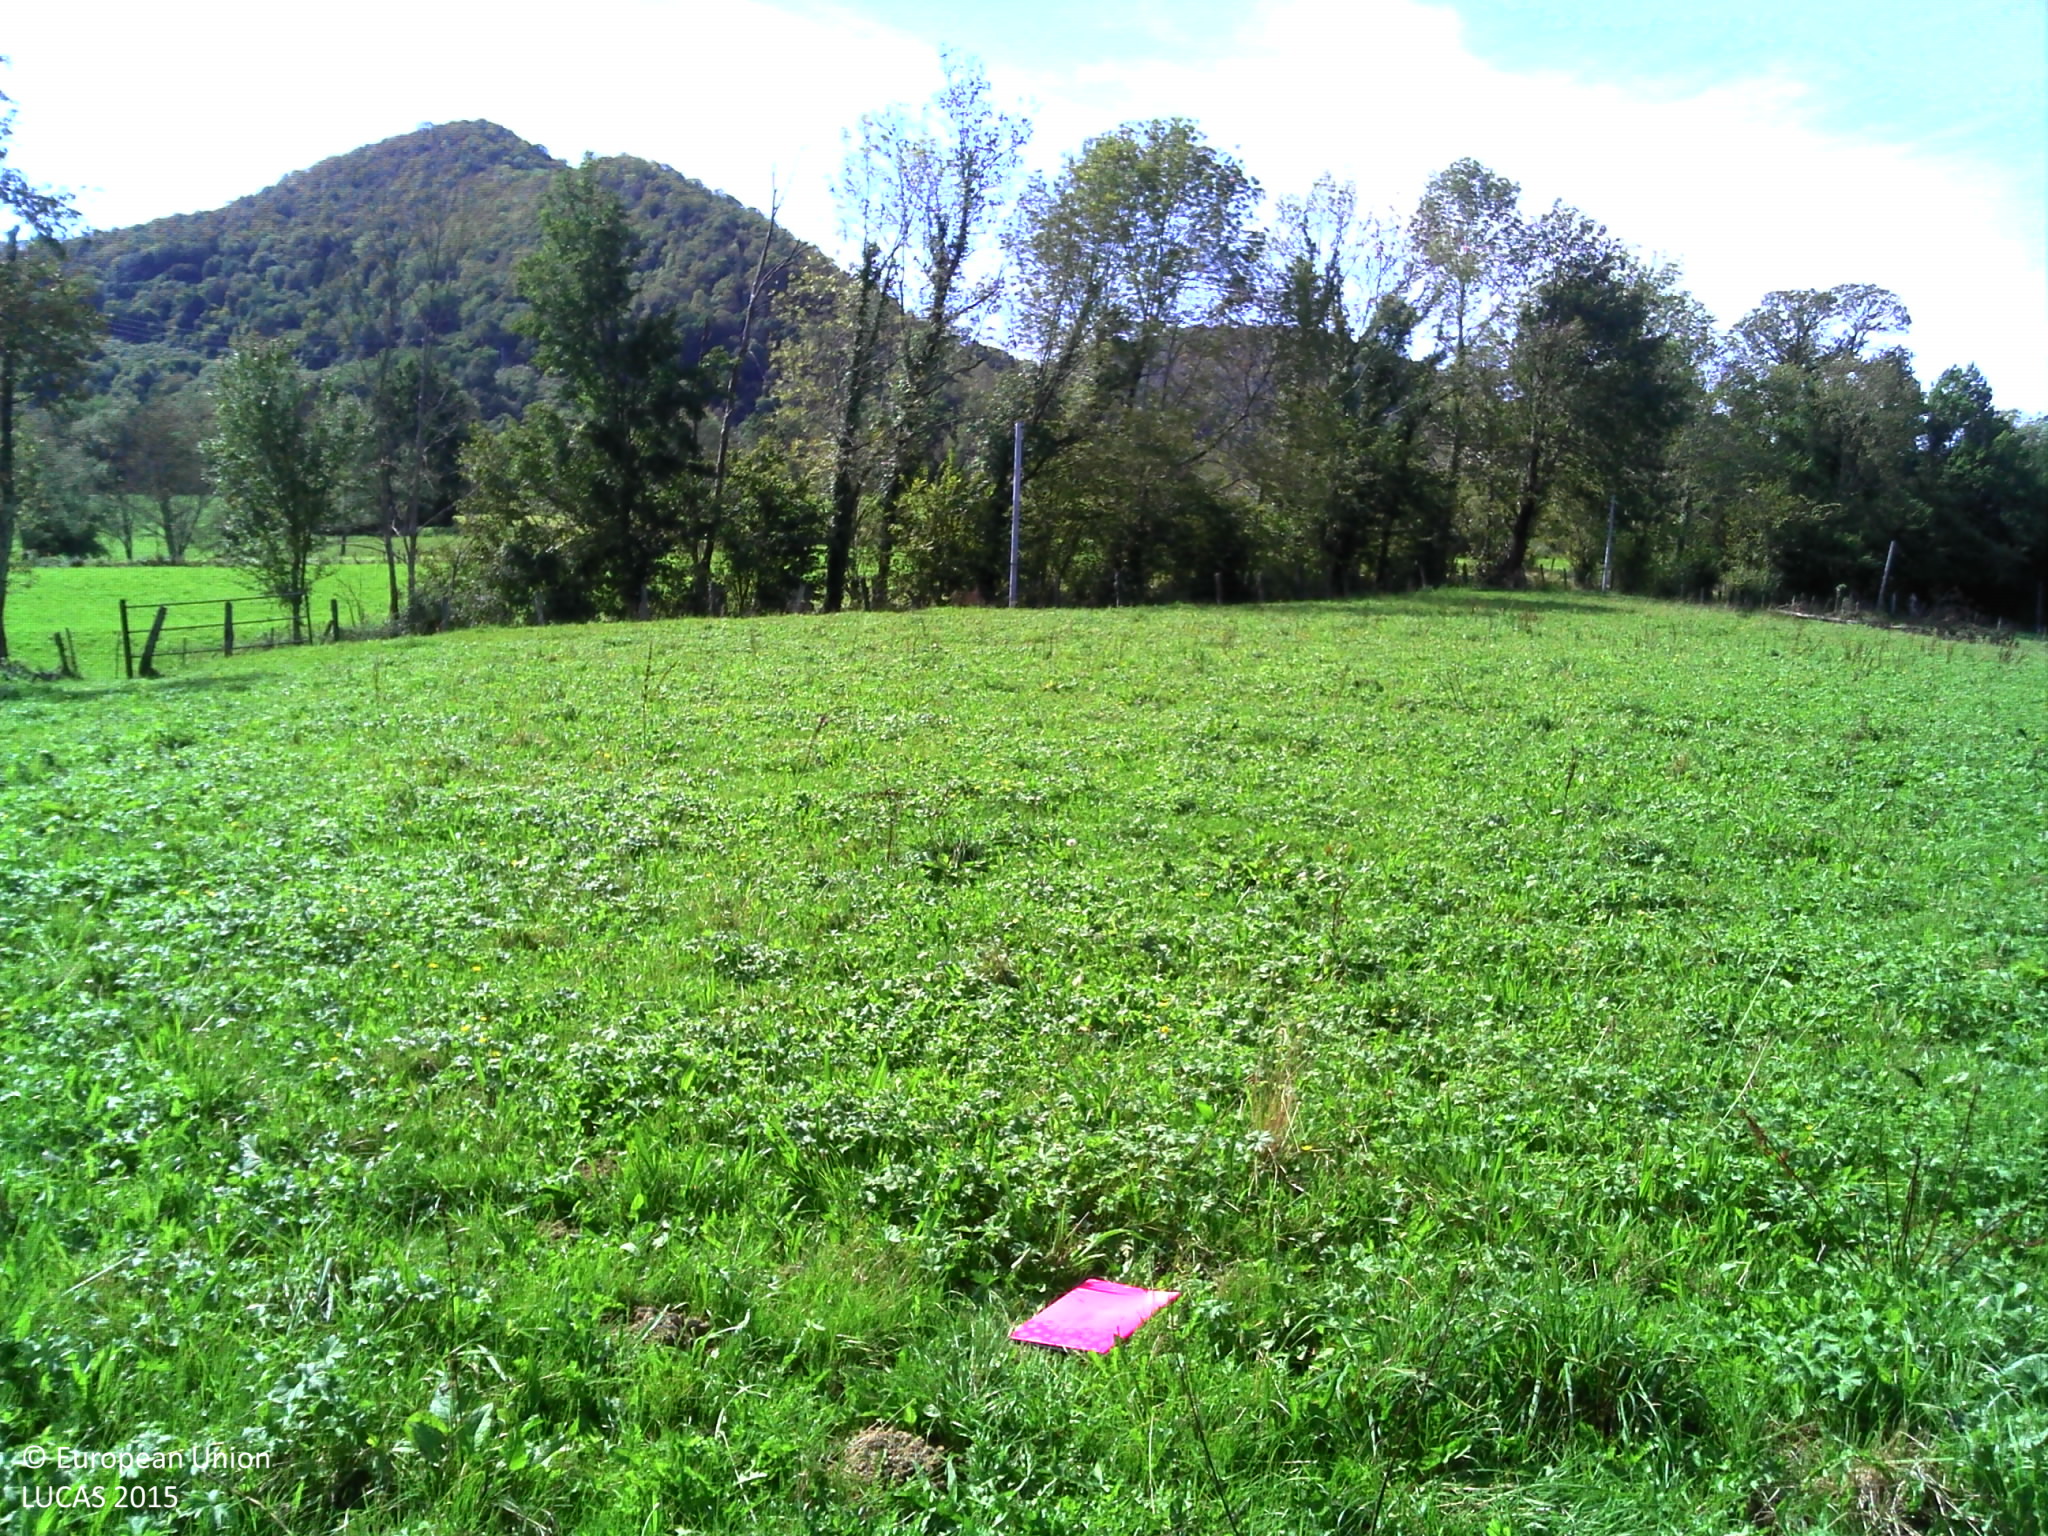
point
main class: Grassland
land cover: Grassland without tree/shrub cover
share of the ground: > 75 %
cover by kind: herbaceous plants 100 %
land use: Agriculture (excluding fallow land and kitchen gardens)
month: September
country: FR
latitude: 43.1316
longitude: -0.6164
